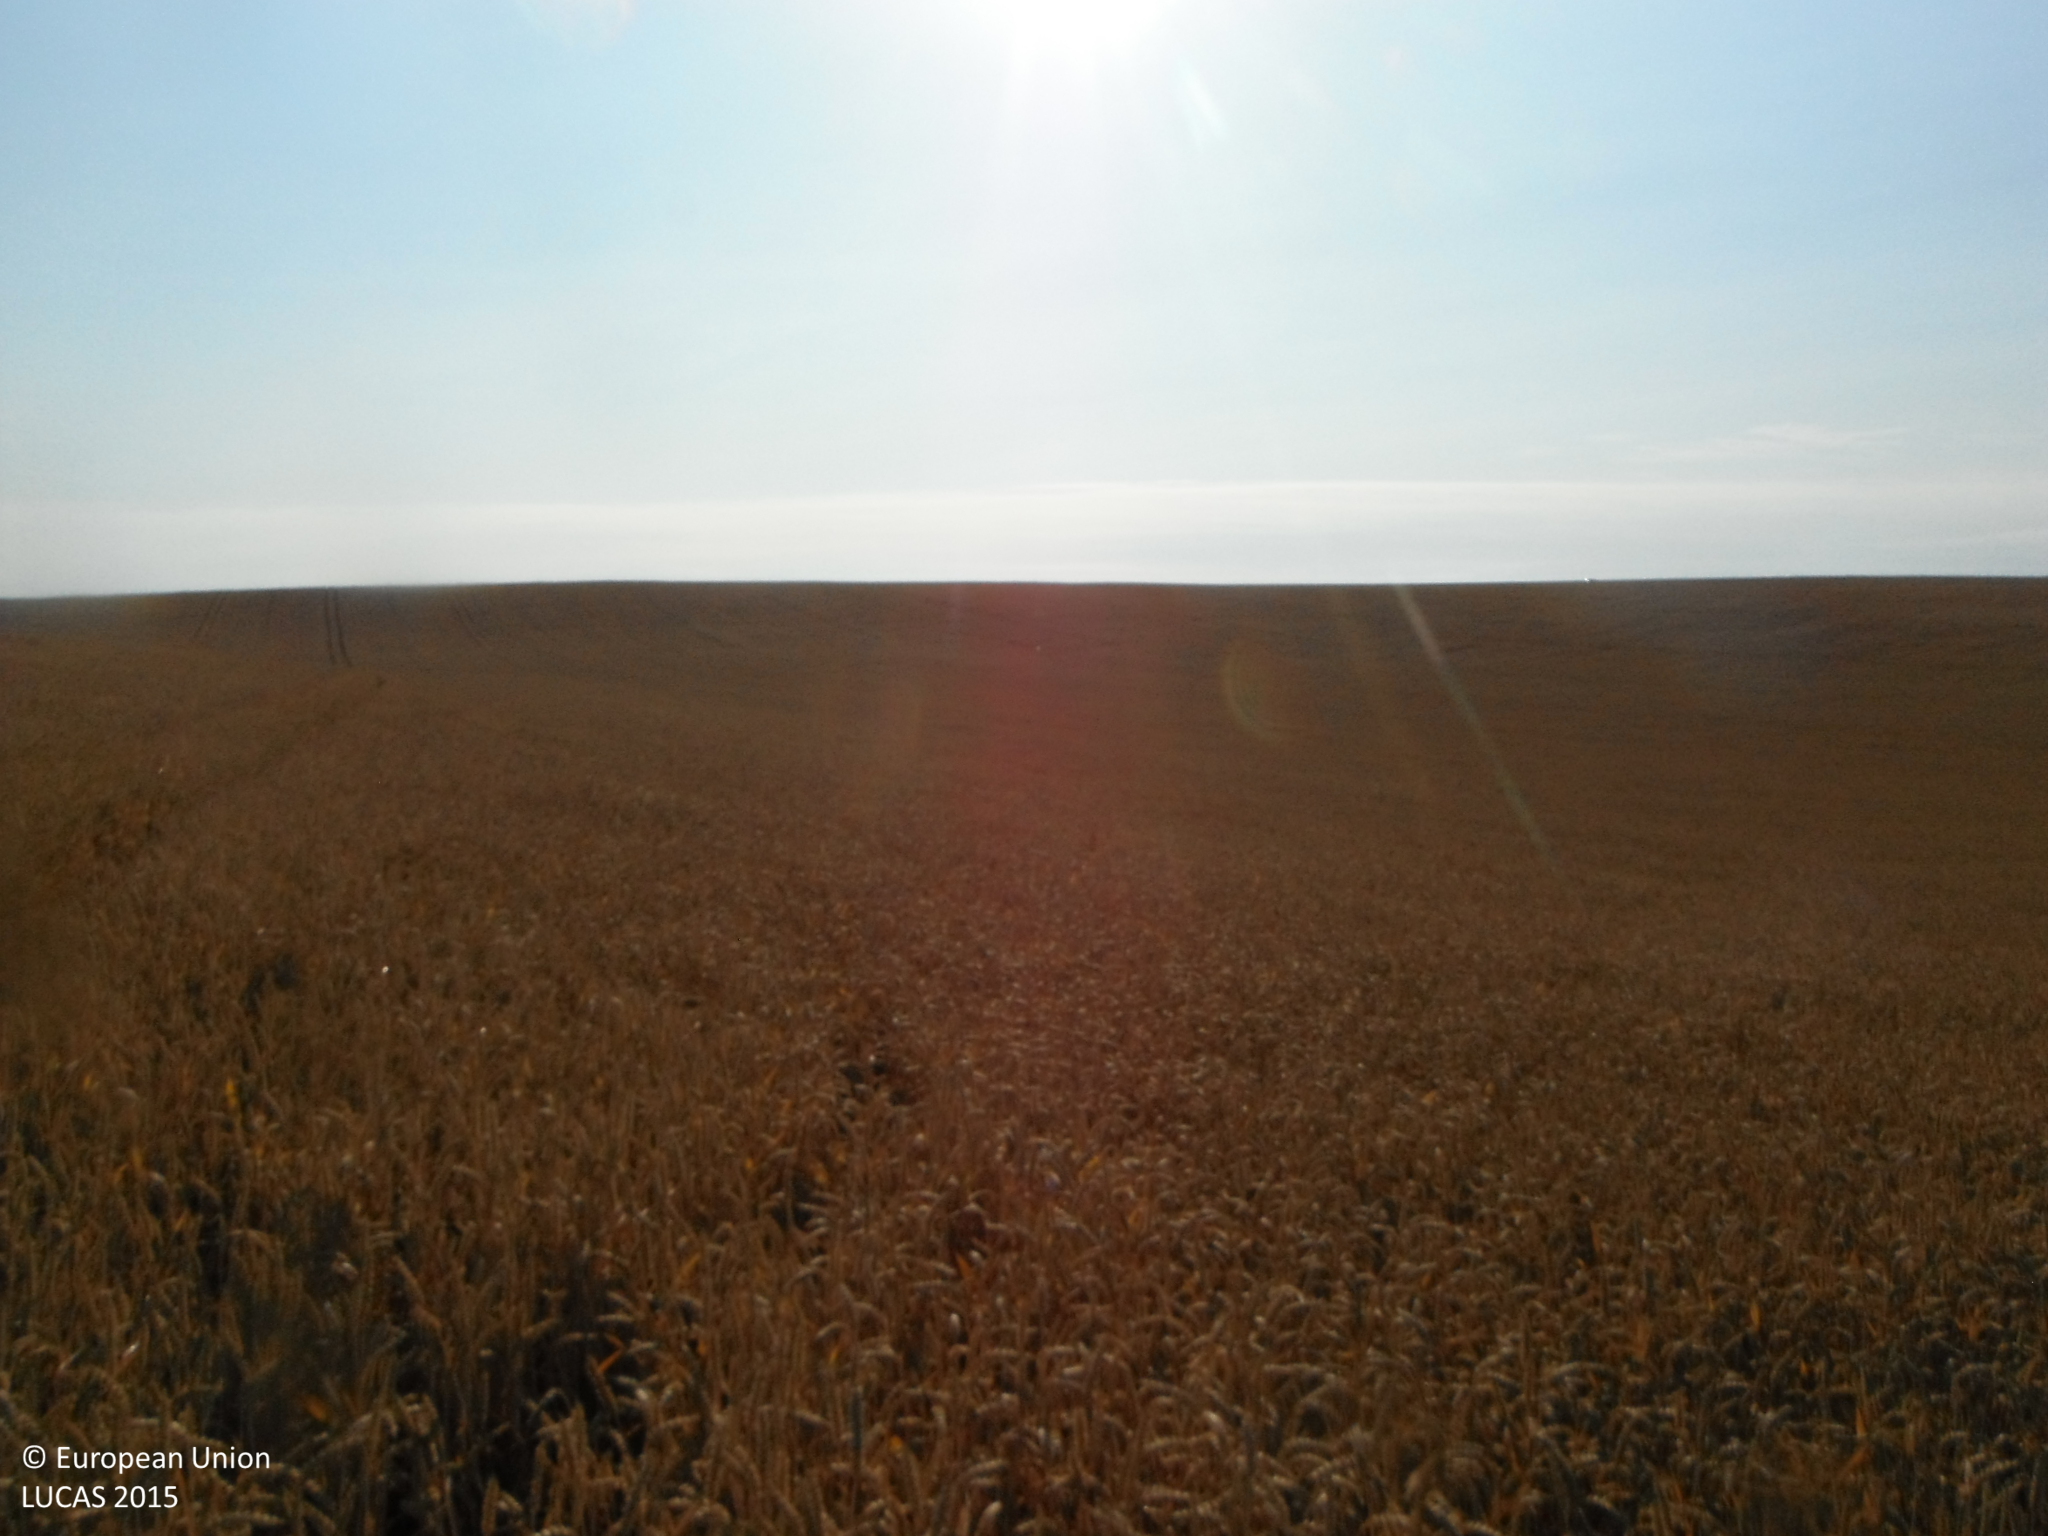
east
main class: Cropland
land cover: Common wheat
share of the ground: > 75 %
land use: Agriculture (excluding fallow land and kitchen gardens)
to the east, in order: Common wheat
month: July
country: SK
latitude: 48.5547
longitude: 17.6392
